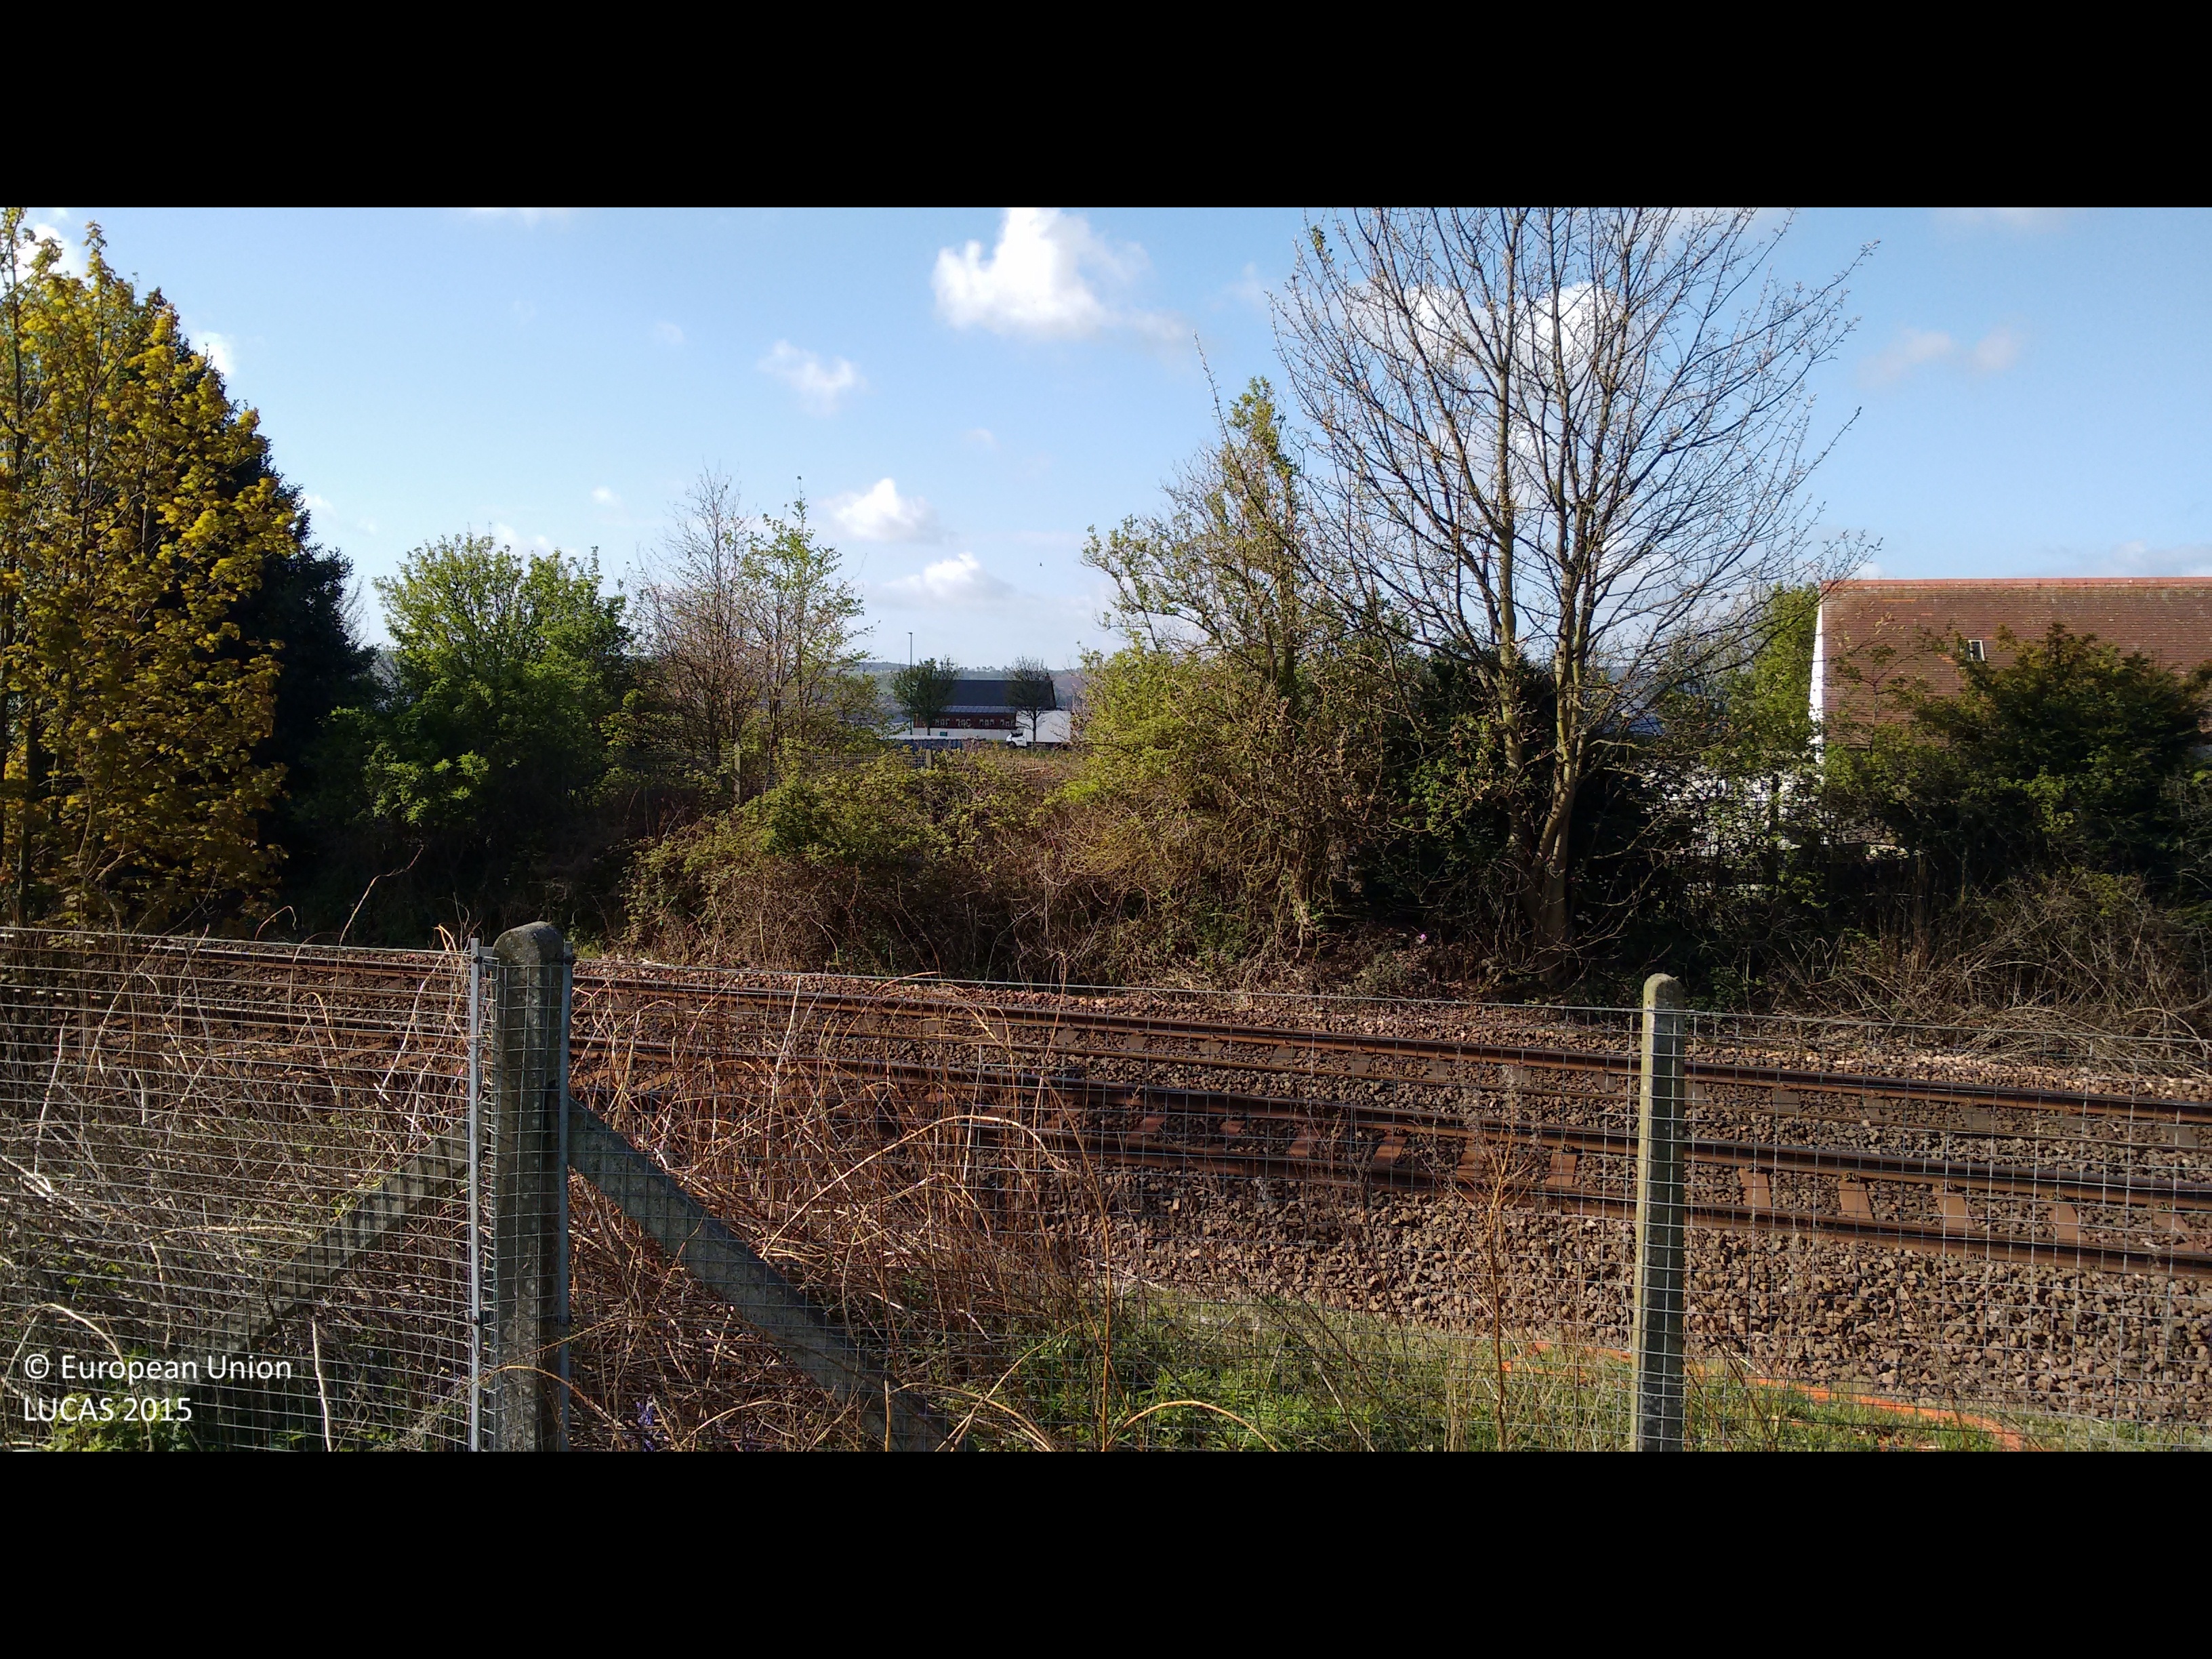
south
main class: Shrubland
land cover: Shrubland without tree cover
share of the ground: > 75 %
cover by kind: herbaceous plants 30 %, shrubs 20 %
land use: Railway transport
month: May
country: GB
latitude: 56.4533
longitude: -2.9976
